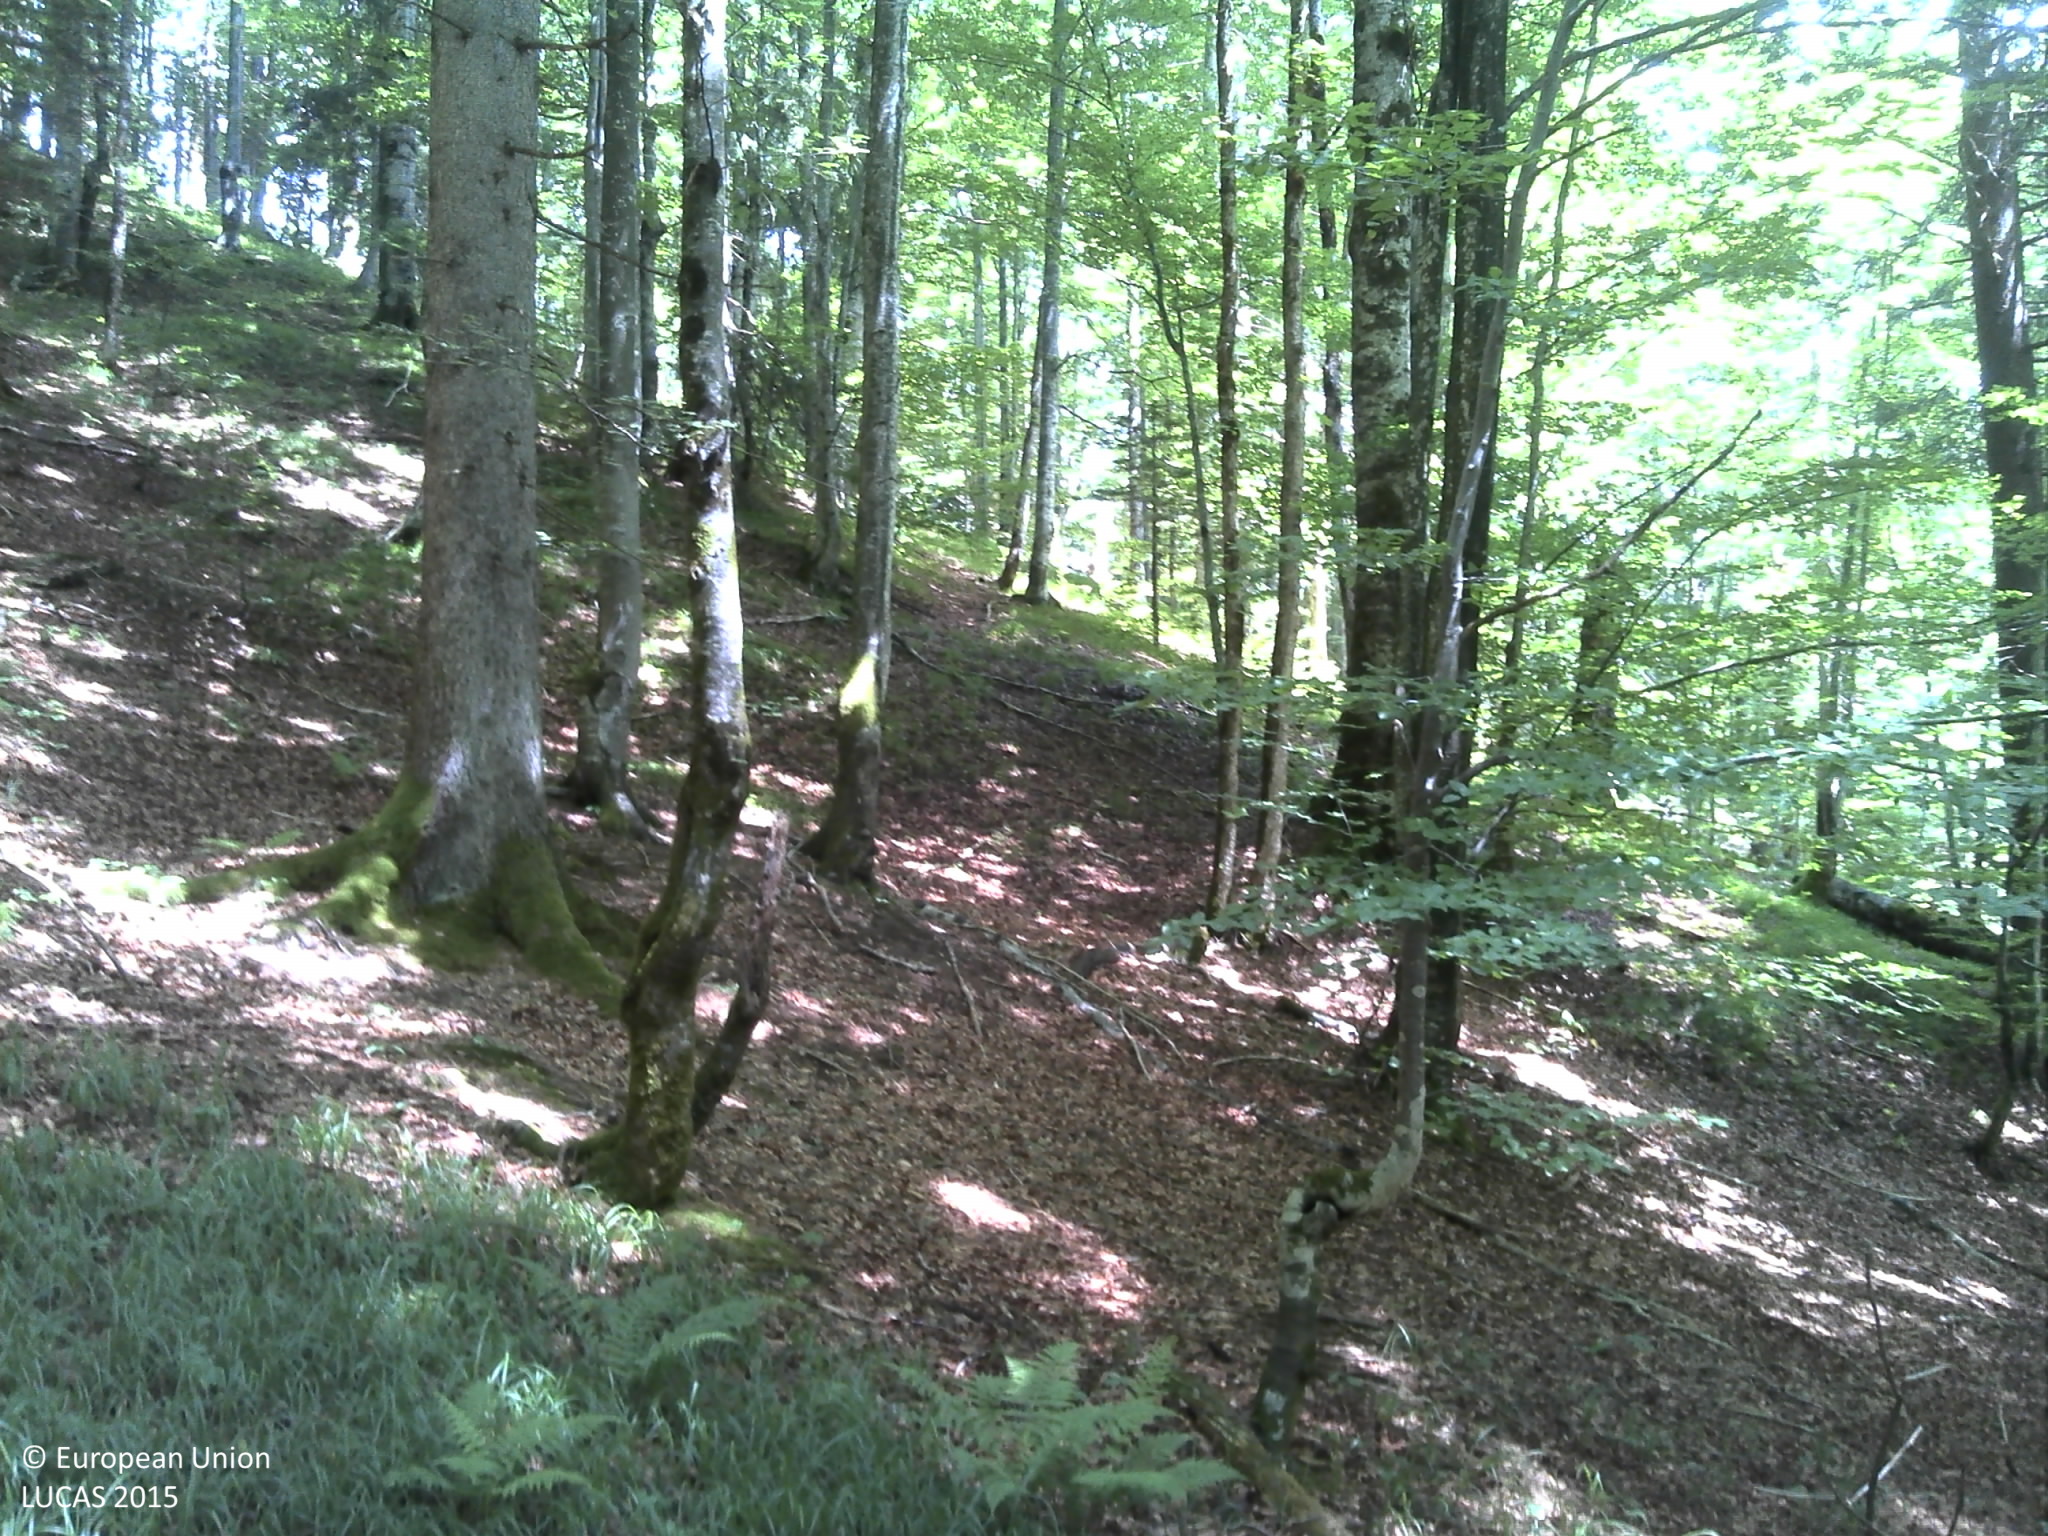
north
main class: Woodland
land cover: Broadleaved woodland
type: beech forest
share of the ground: > 75 %
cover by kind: broadleaved forest trees 95 %, consolidated bare surface 5 %
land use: Semi-natural and natural areas not in use
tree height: > 5 m
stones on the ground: < 10 %
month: June
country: HR
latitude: 44.8486
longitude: 15.6249
